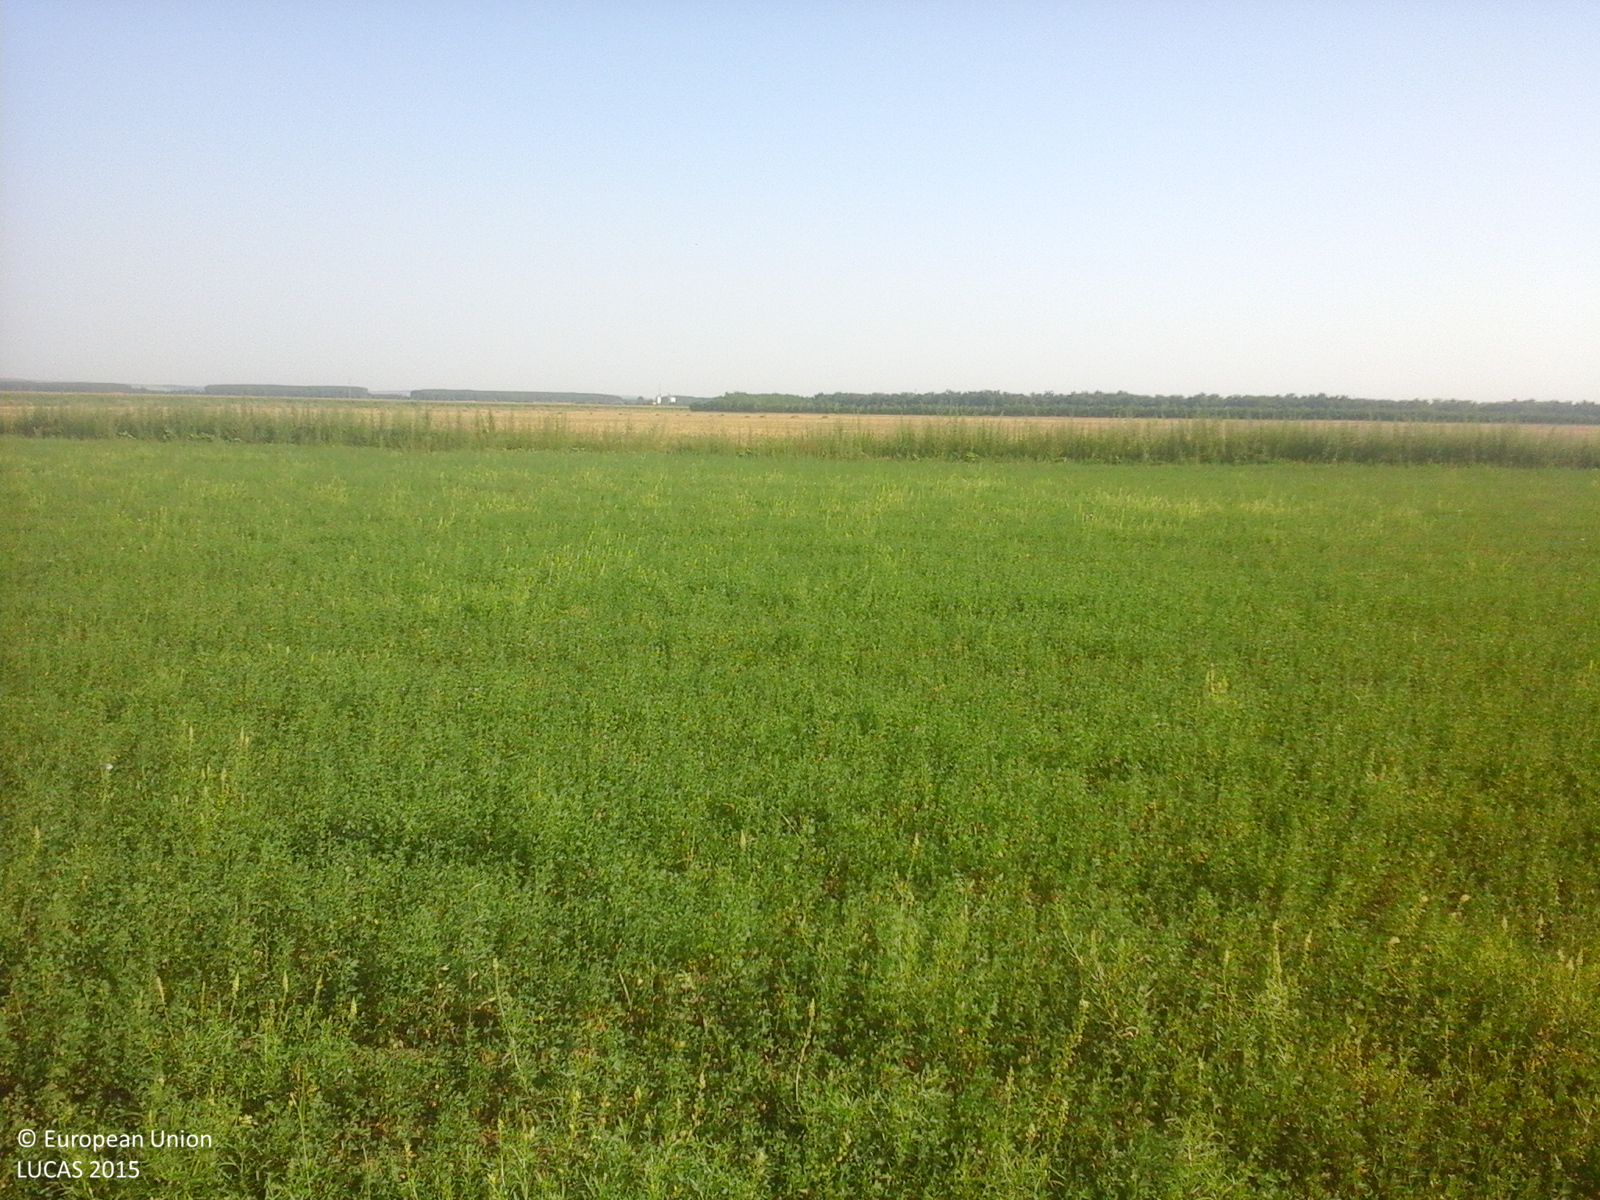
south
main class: Cropland
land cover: Lucerne
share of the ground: > 75 %
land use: Agriculture (excluding fallow land and kitchen gardens)
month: July
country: RO
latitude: 44.2385
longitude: 27.4554
